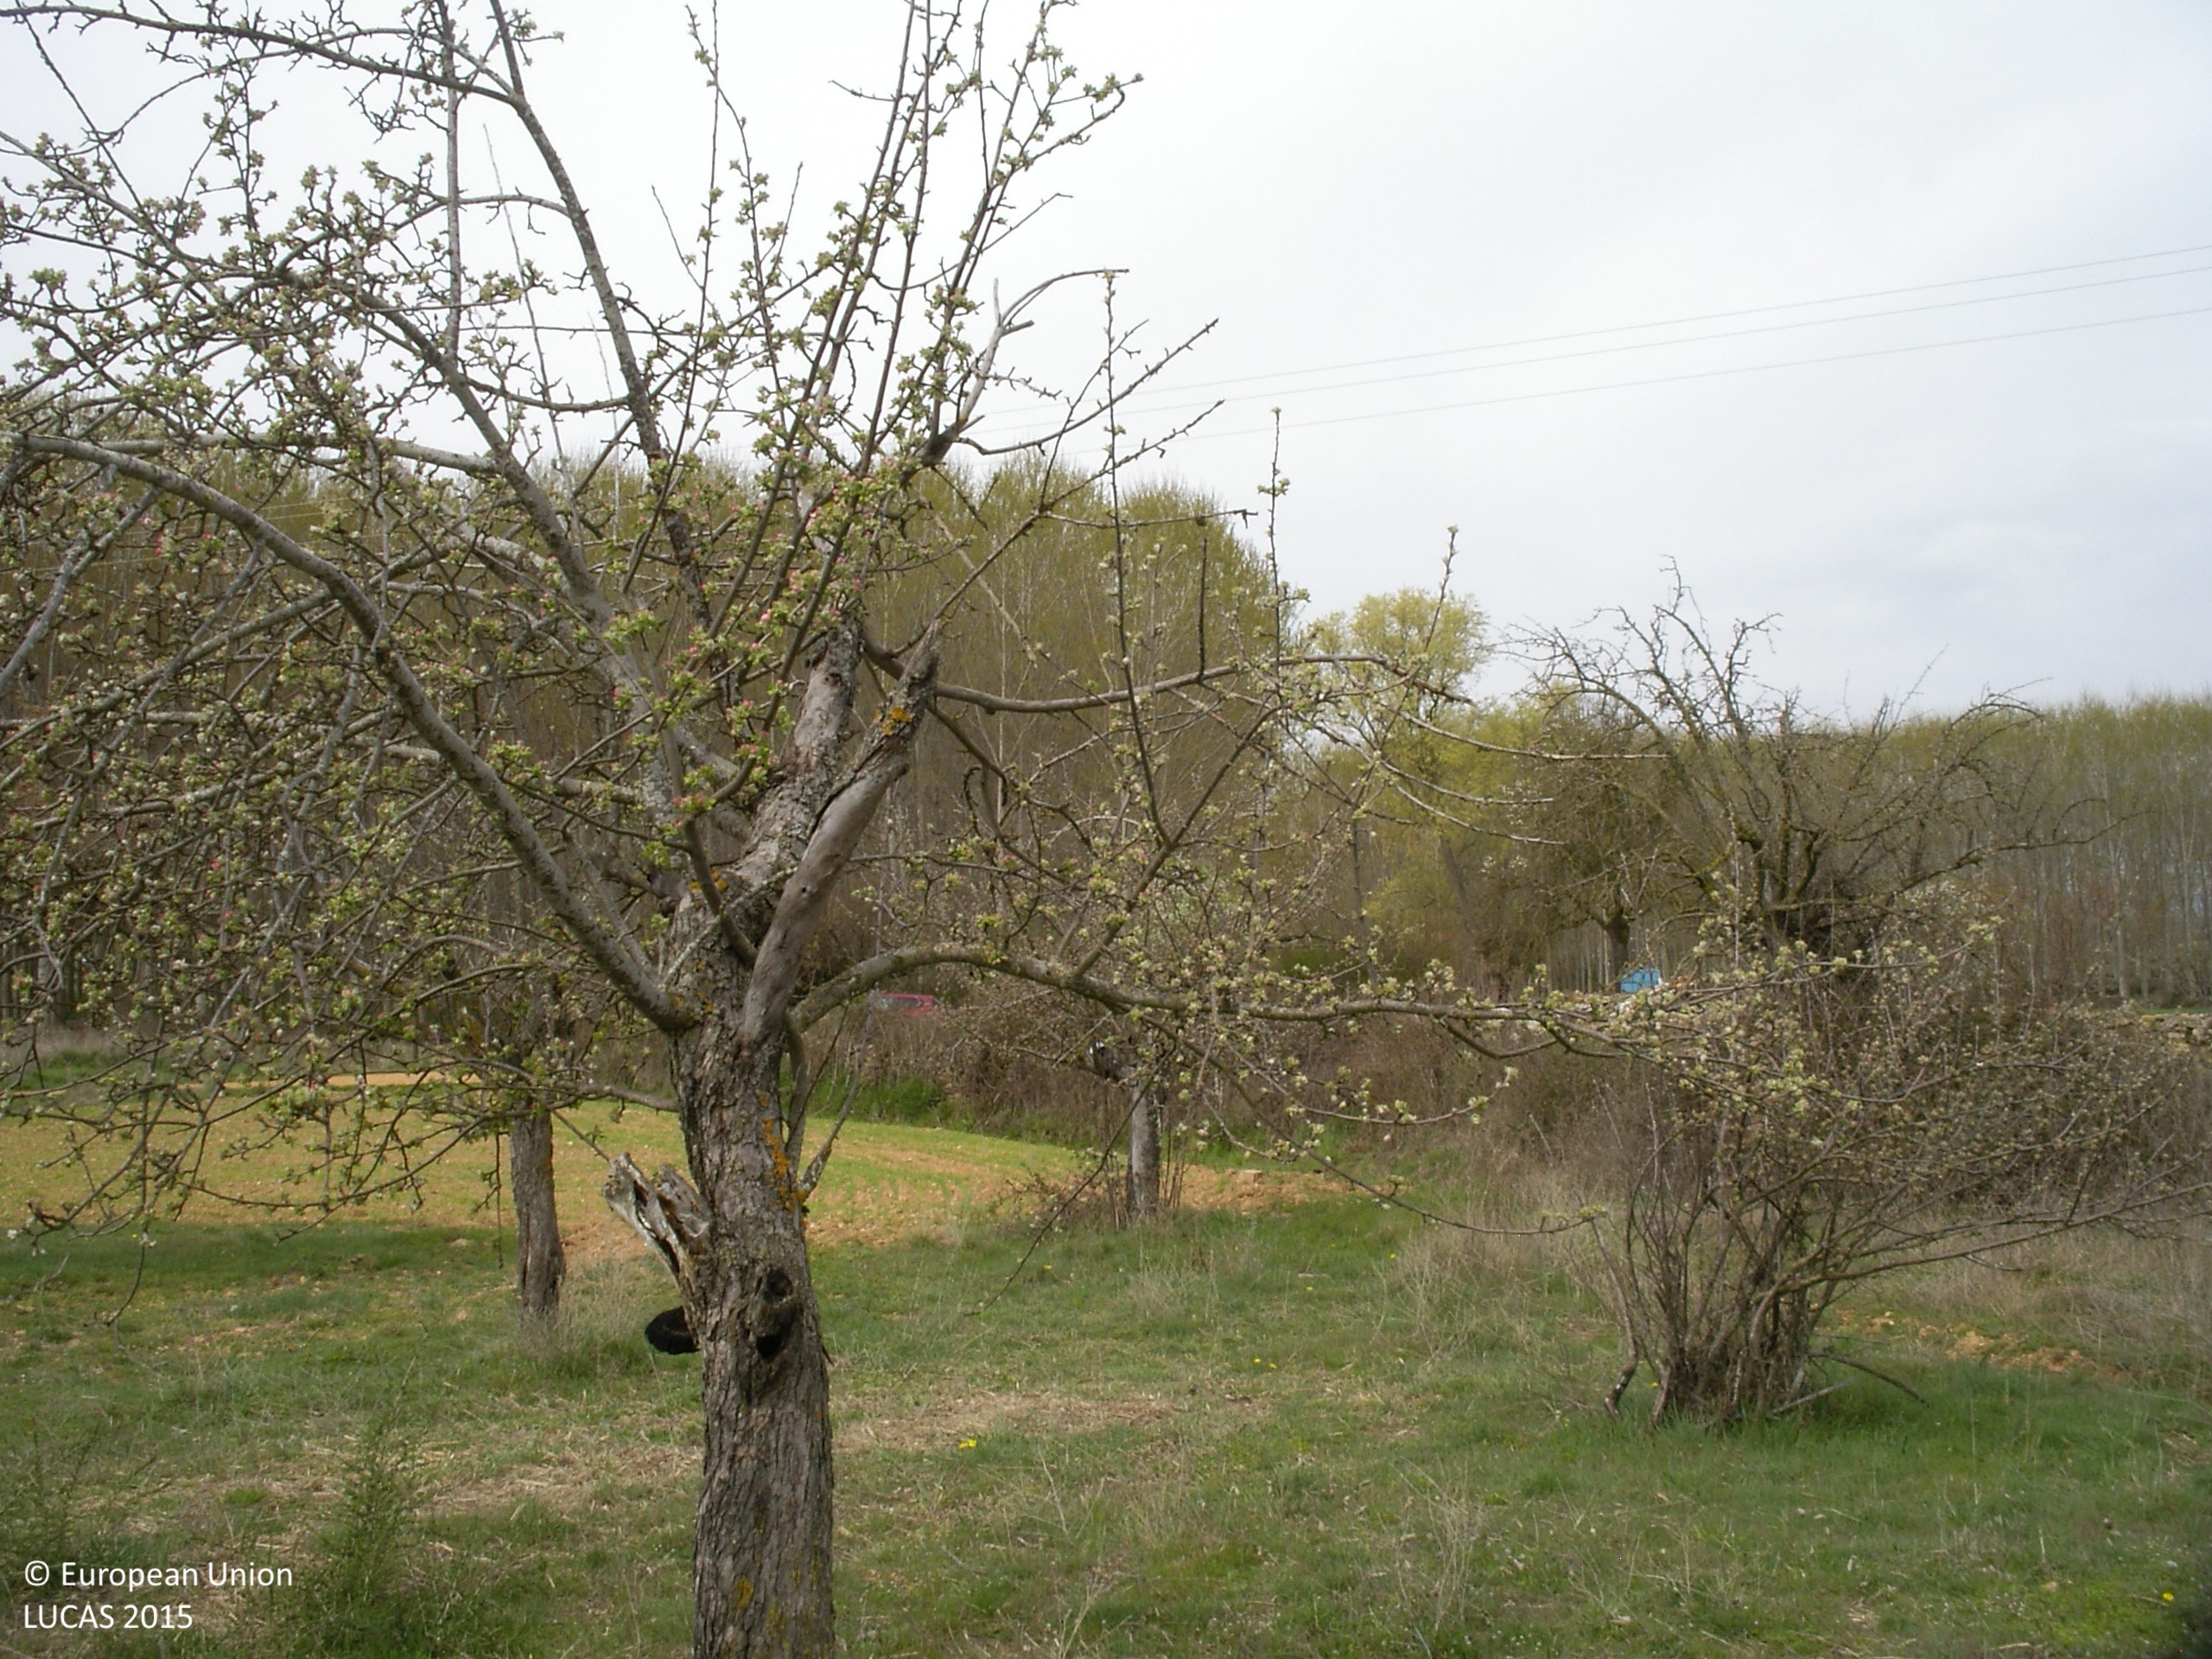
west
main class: Grassland
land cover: Grassland with sparse tree/shrub cover
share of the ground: > 75 %
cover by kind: herbaceous plants 90 %, coniferous forest trees 5 %, shrubs 5 %
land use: Agriculture (excluding fallow land and kitchen gardens)
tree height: < 5 m
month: April
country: ES
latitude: 42.4201
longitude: -6.1122
